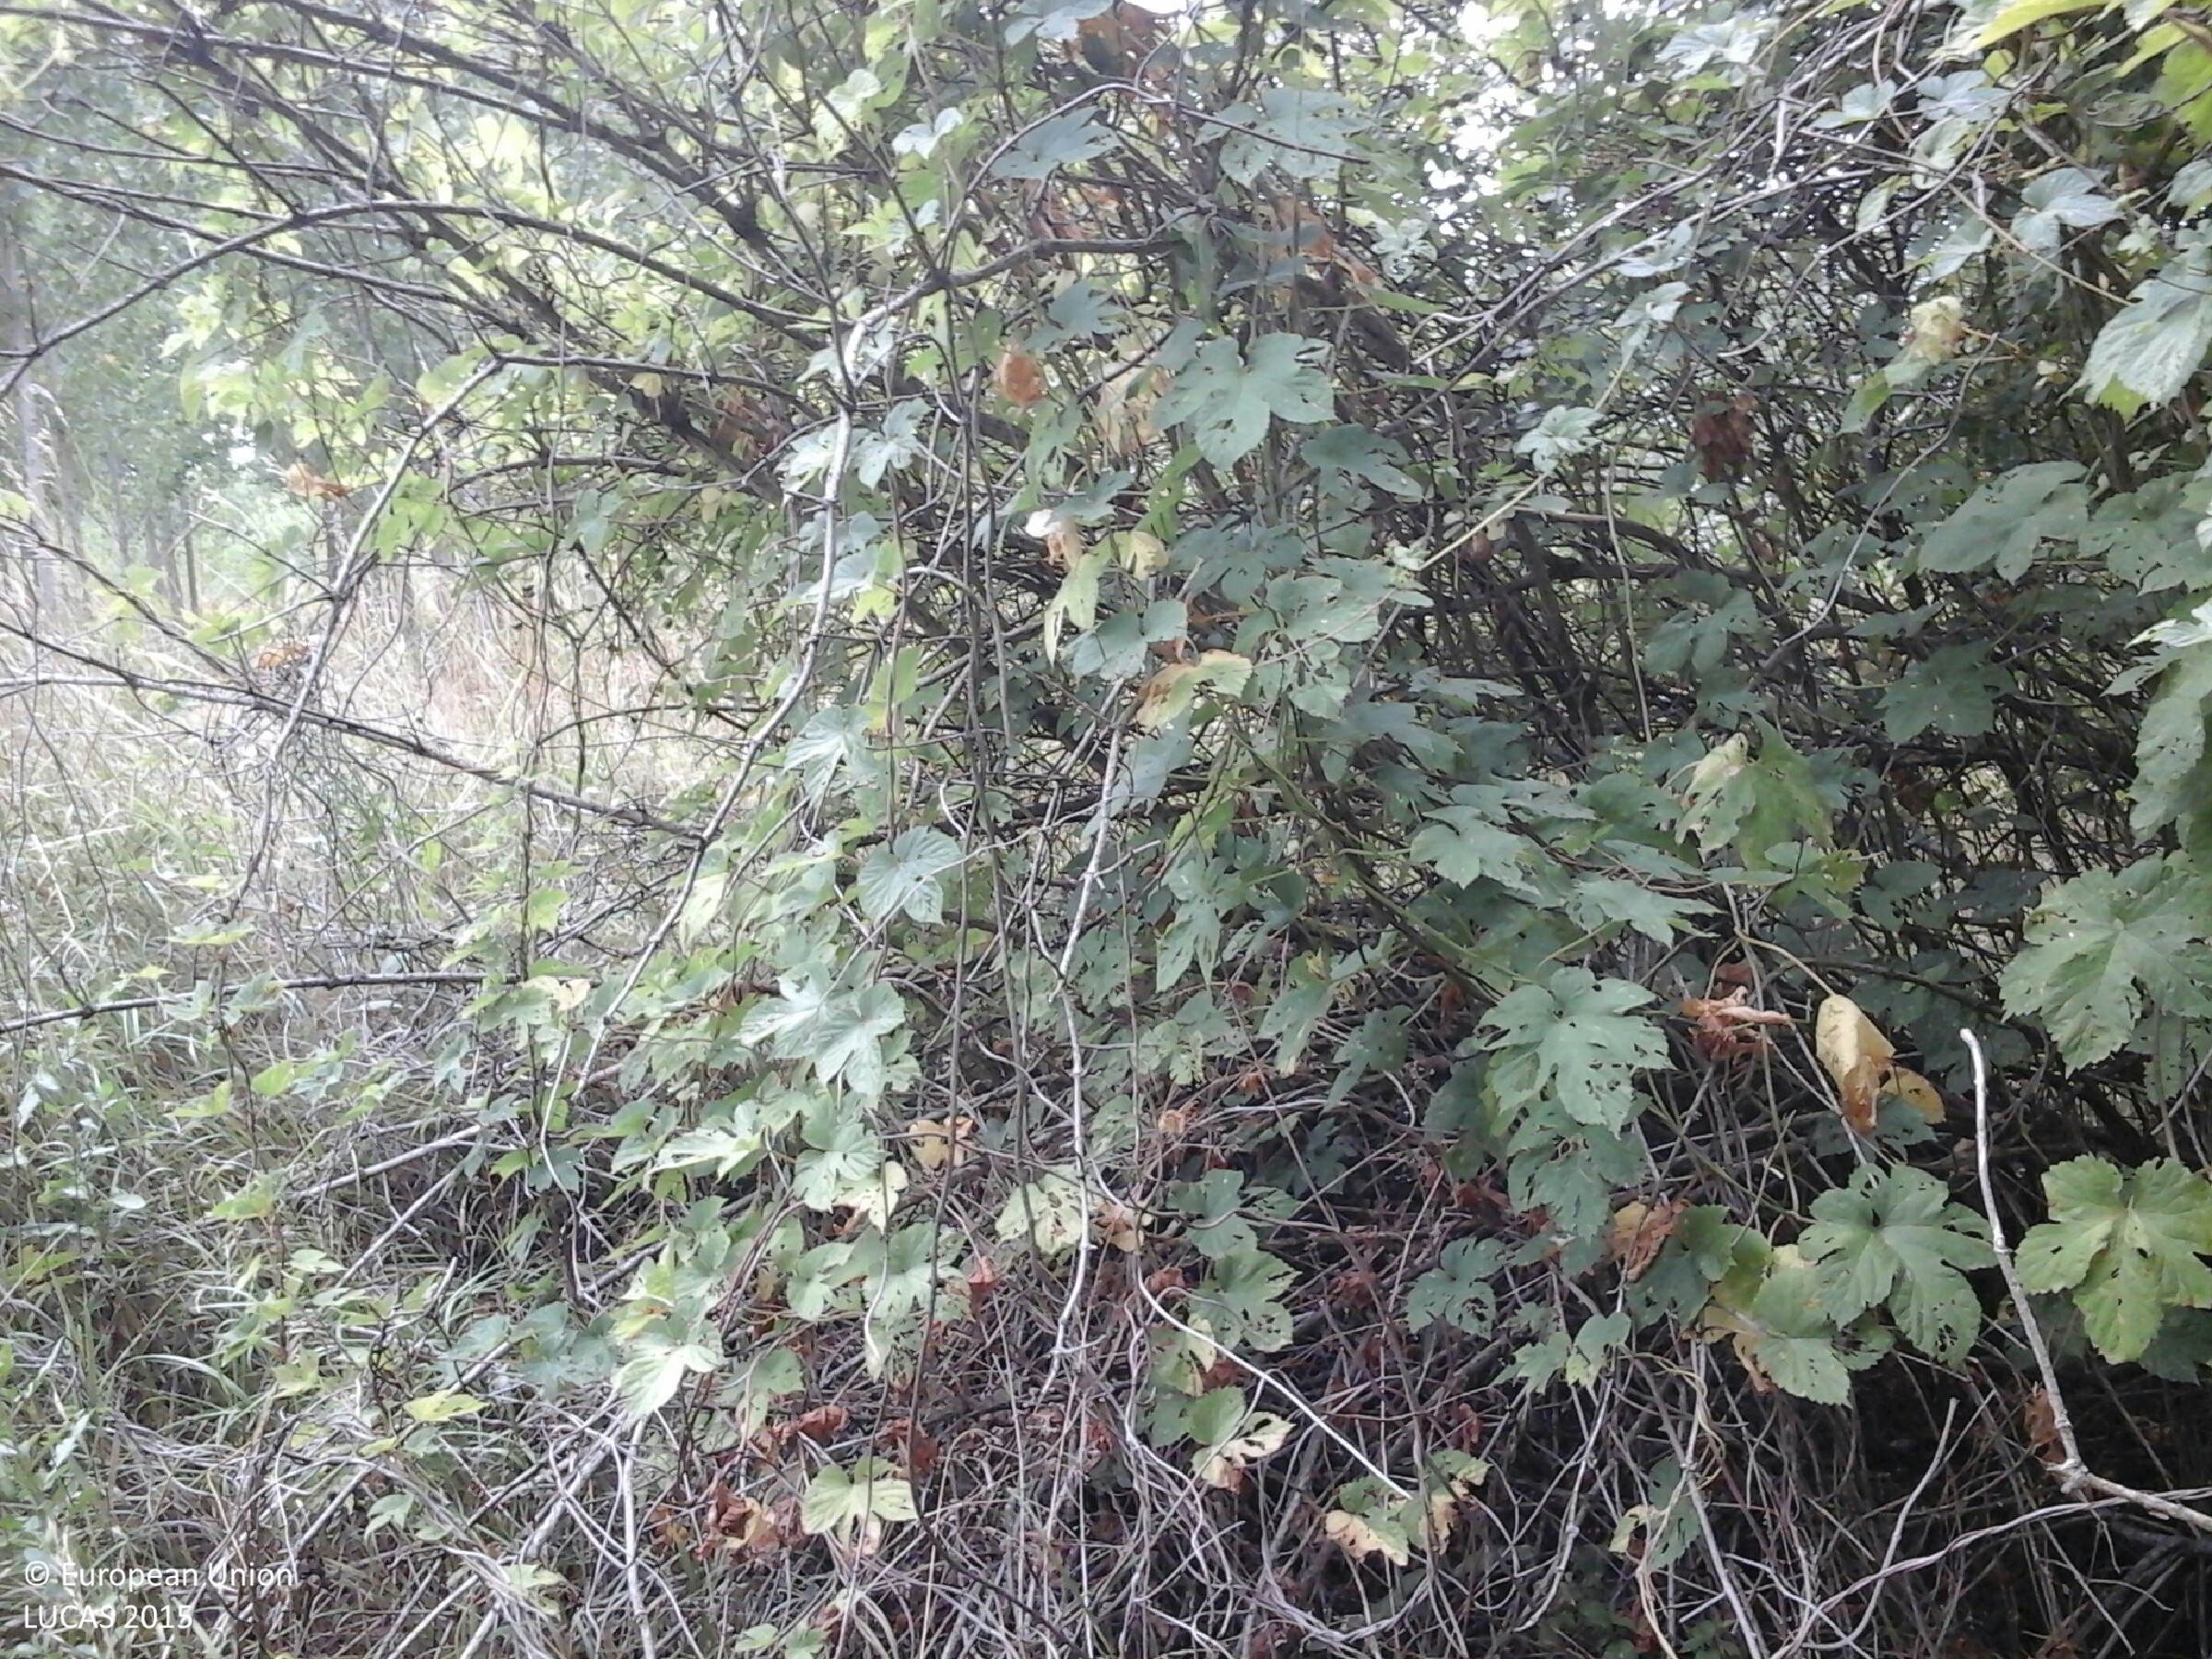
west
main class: Woodland
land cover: Broadleaved woodland
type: mesophytic deciduous forest
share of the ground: 50 - 75 %
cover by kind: broadleaved forest trees 70 %, herbaceous plants 30 %
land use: Forestry
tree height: > 5 m
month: July
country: HU
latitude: 47.5277
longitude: 20.6183
